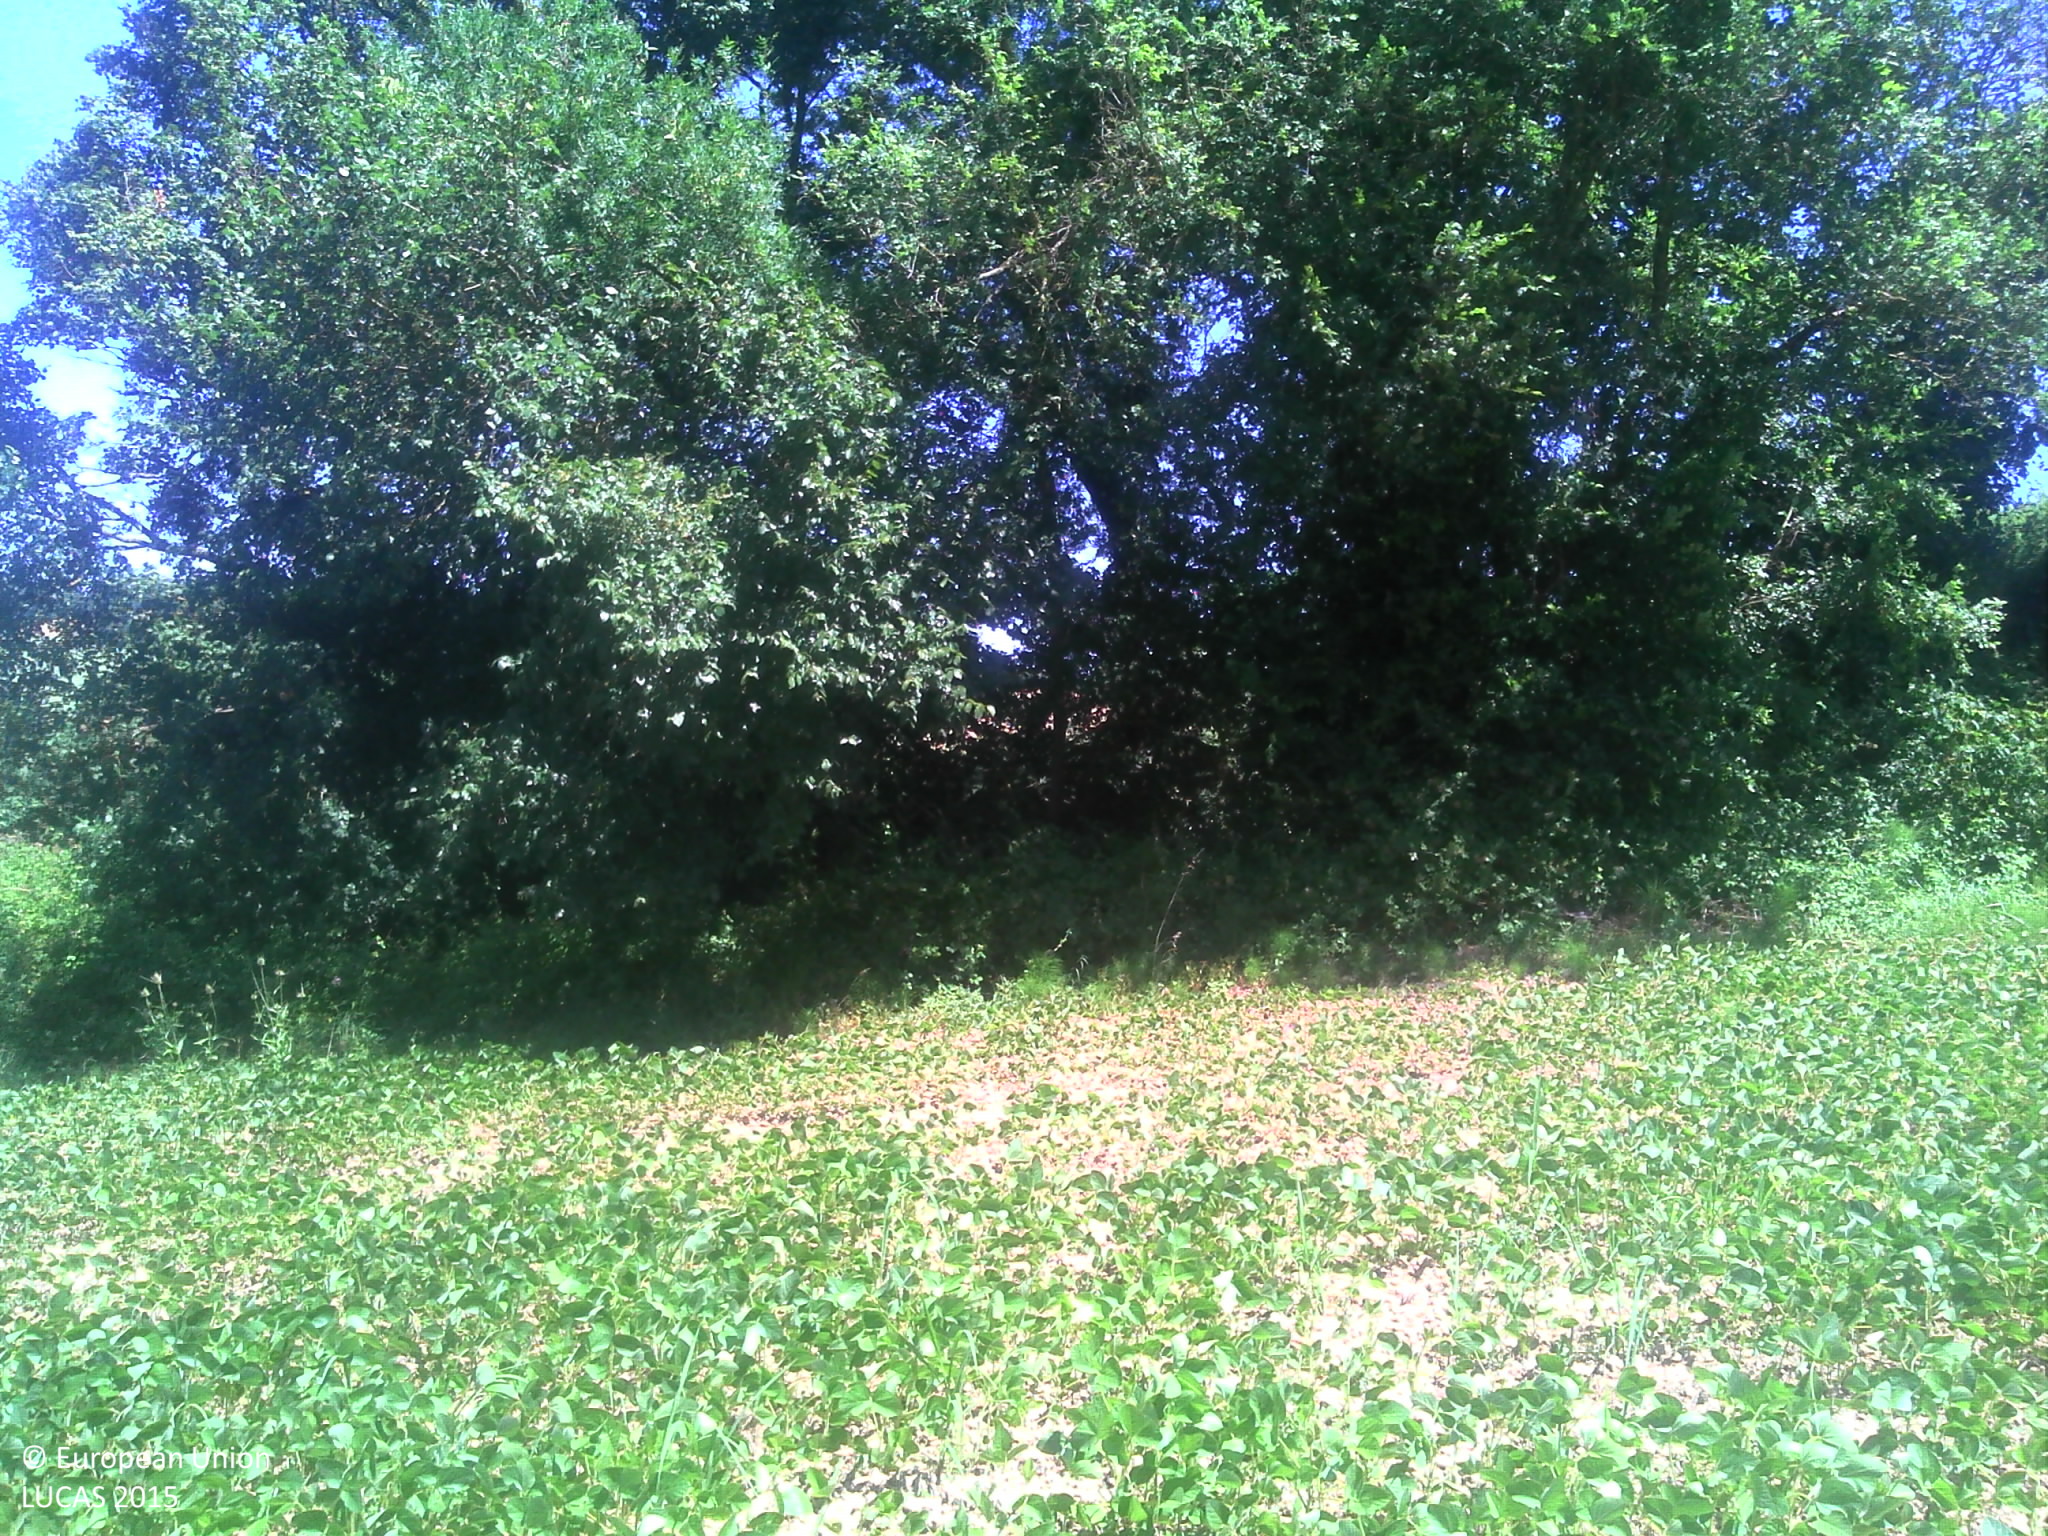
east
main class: Cropland
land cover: Soya
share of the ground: > 75 %
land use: Agriculture (excluding fallow land and kitchen gardens)
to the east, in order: Soya; Abandoned hedges; Ditches and canals; Broadleaved woodland; Grassland without tree/shrub cover; Fences; Single bushes/trees; Grassland without tree/shrub cover
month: July
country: FR
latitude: 43.4366
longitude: 1.0445
